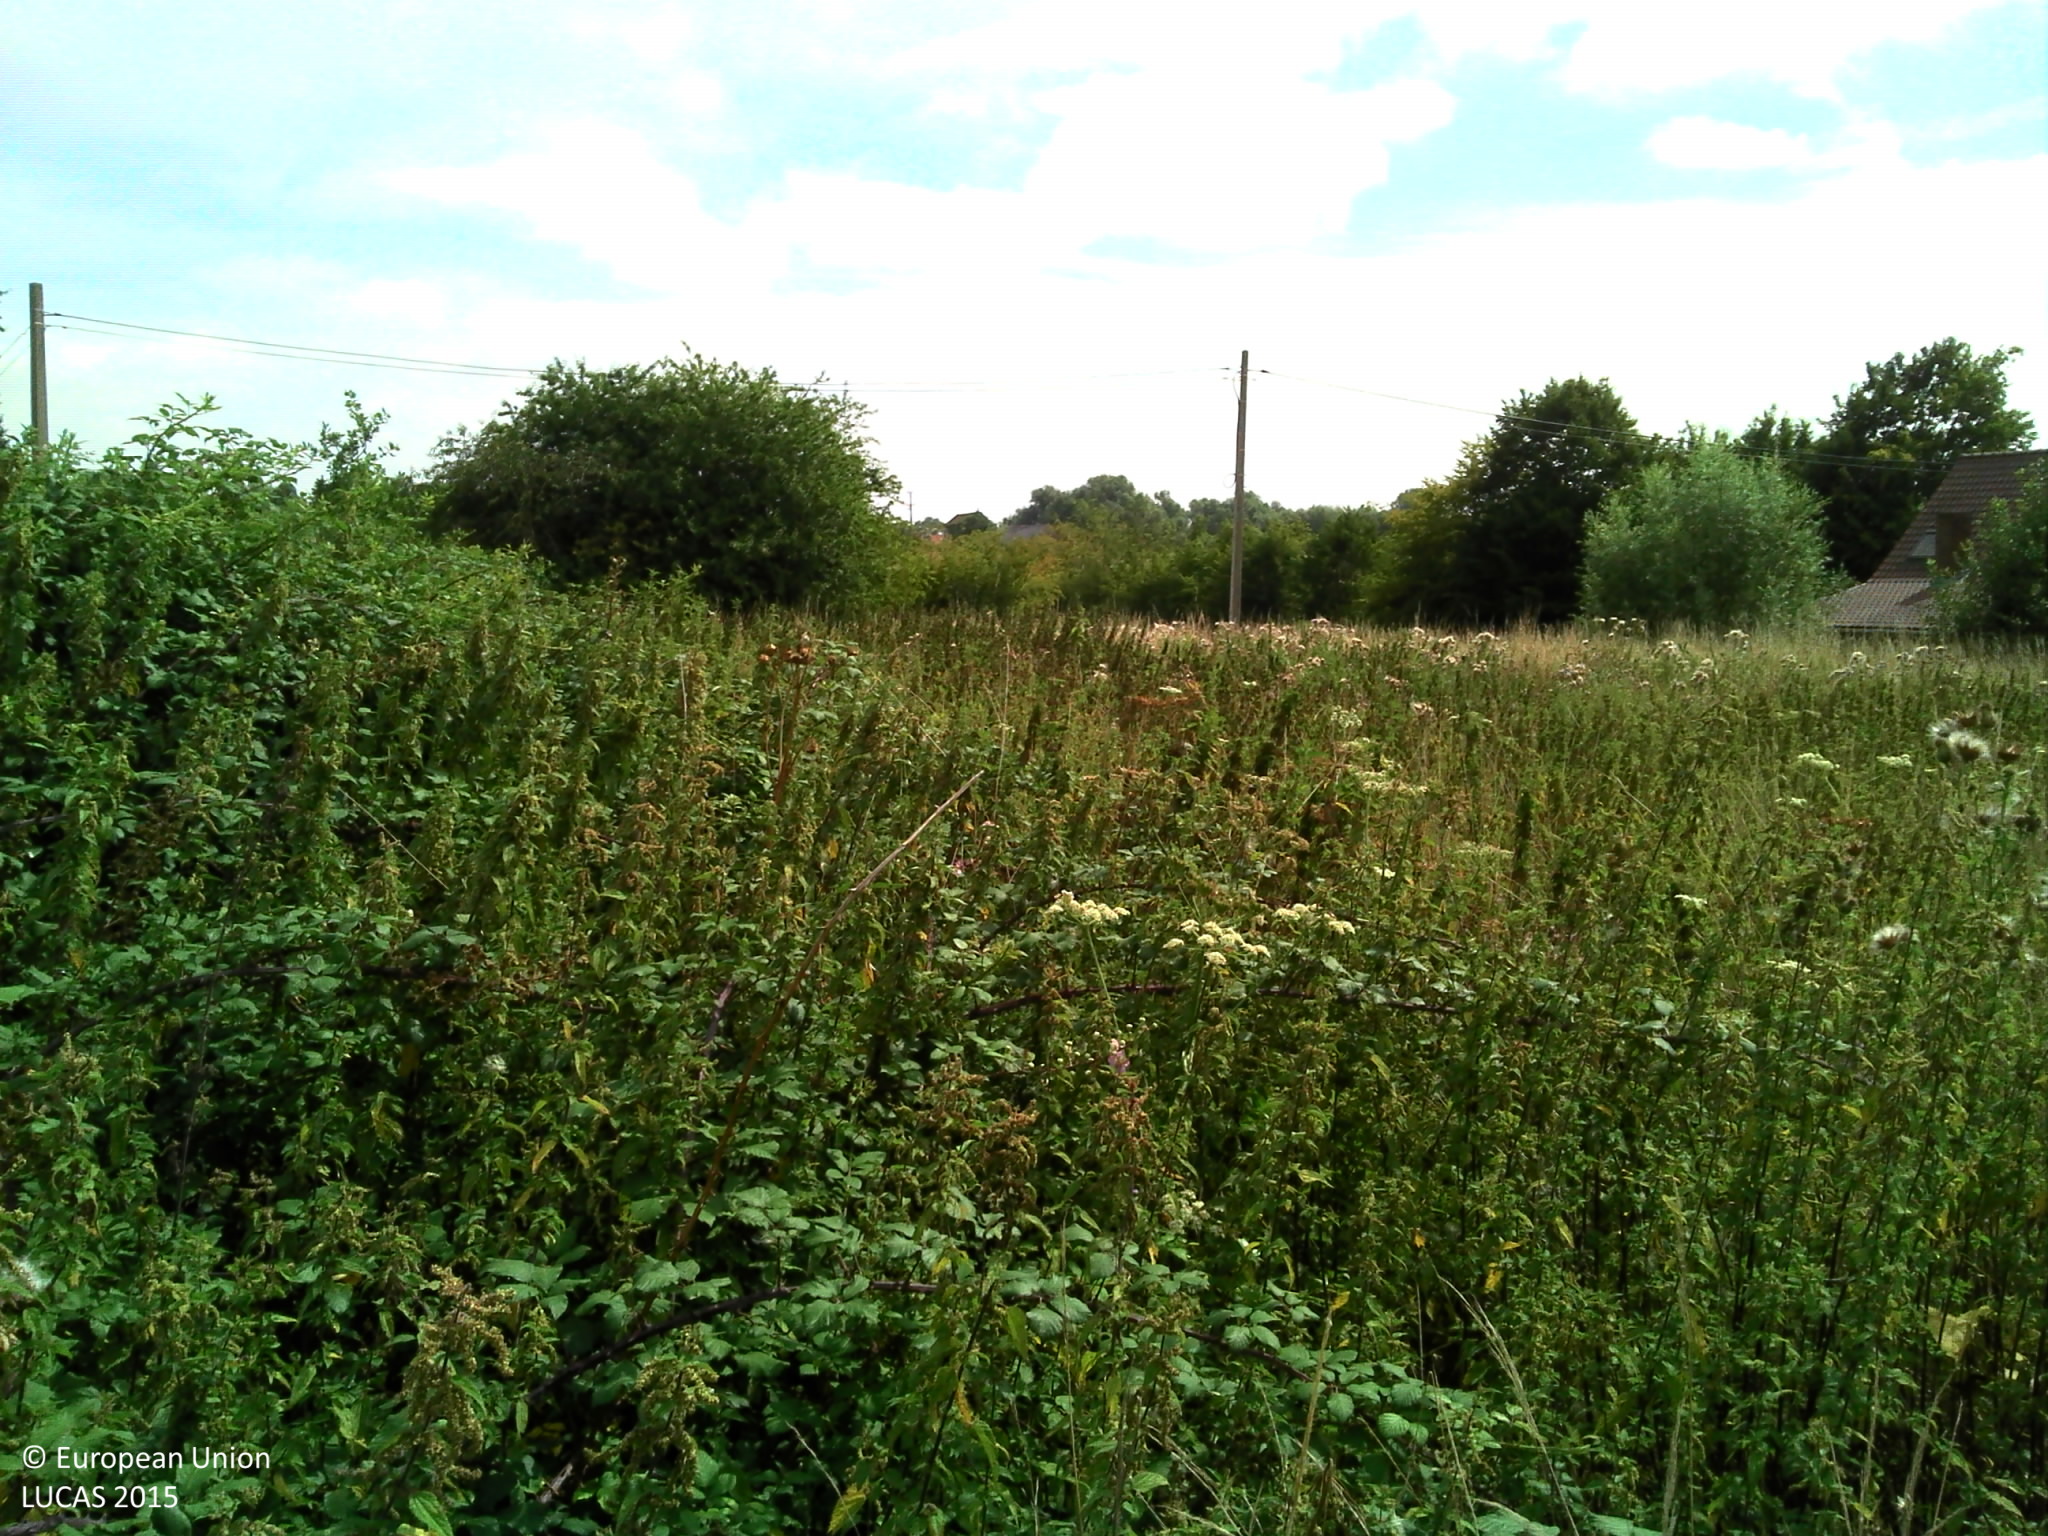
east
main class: Cropland
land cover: Potatoes
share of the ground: > 75 %
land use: Agriculture (excluding fallow land and kitchen gardens)
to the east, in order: Potatoes; Fences; Broadleaved woodland; Grassland without tree/shrub cover; Fences; Electric lines; Grass margins; Paved roads, cycling and walking lanes; Grass margins; Ditches and canals; Fences; Grassland without tree/shrub cover; Fences; Grass margins; Sugar beet
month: August
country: BE
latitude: 50.7370
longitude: 3.8013
